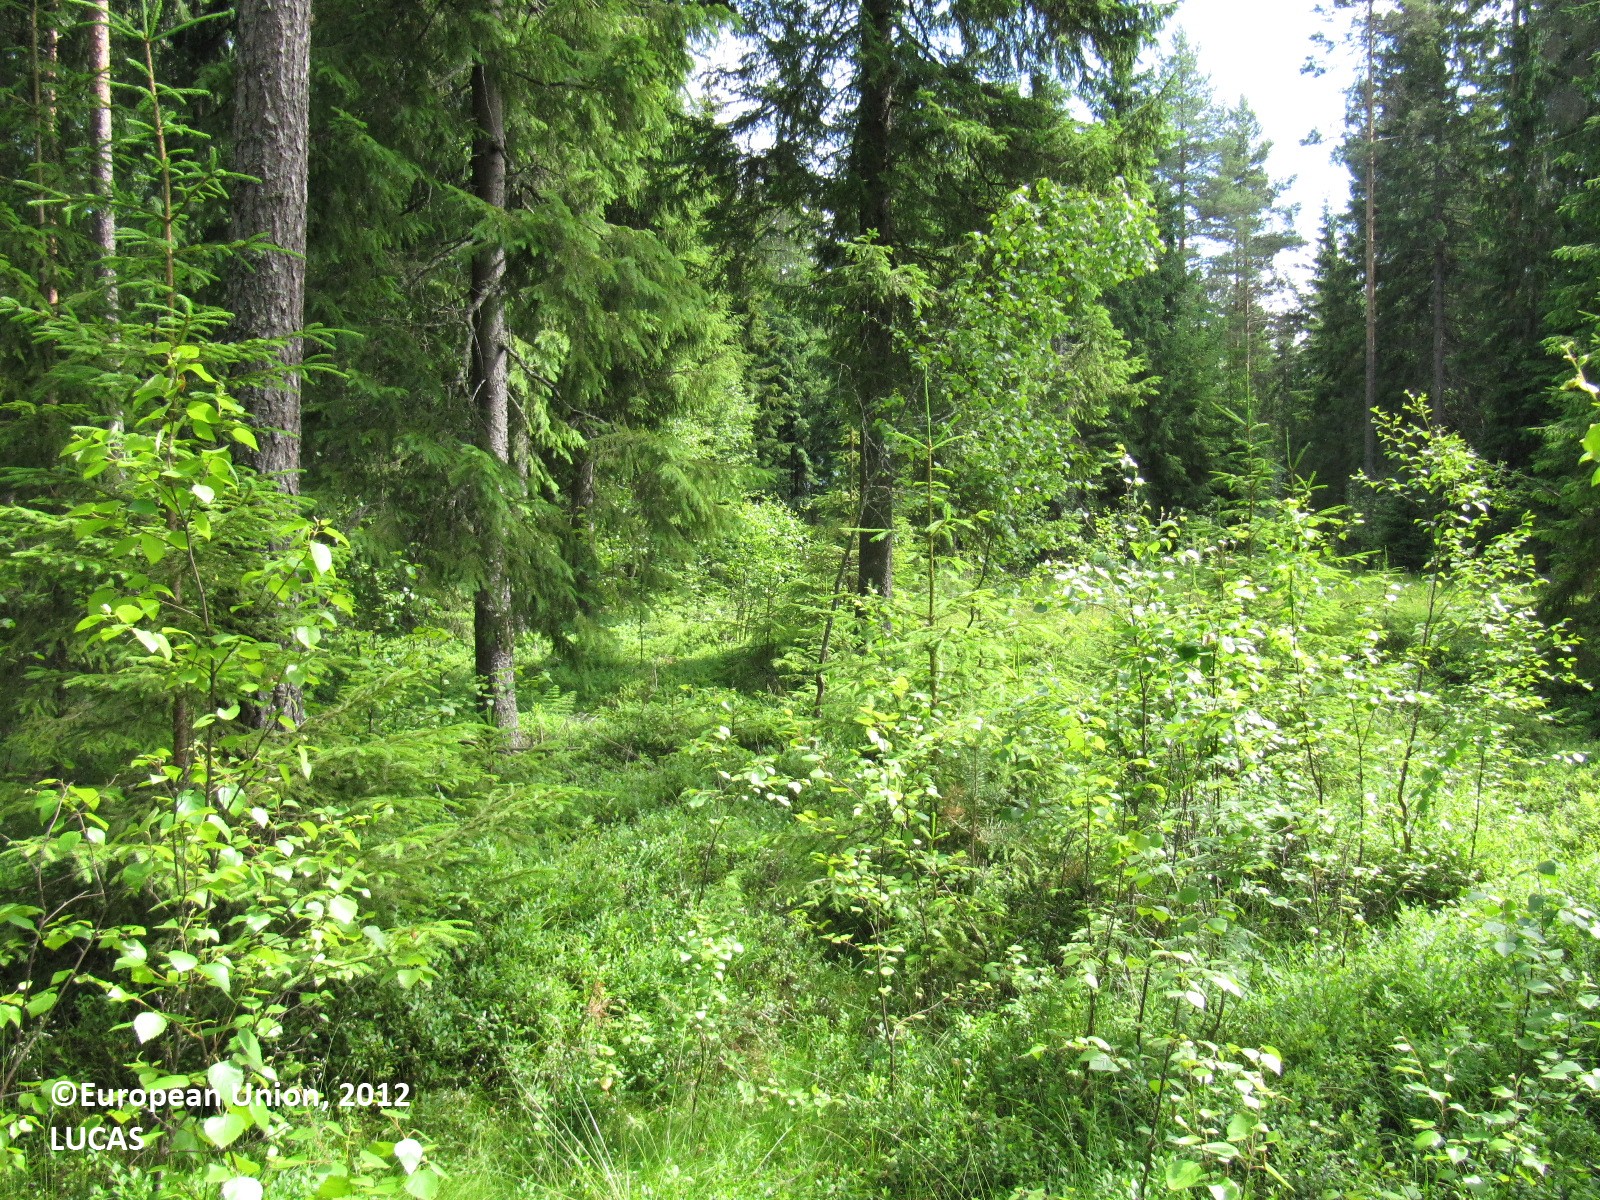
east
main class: Woodland
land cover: Other coniferous woodland
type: boreal forest
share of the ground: > 75 %
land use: Forestry
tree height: > 5 m
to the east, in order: Other coniferous woodland; Spruce dominated mixed woodland; Rivers and streams; Spruce dominated mixed woodland; Grassland with sparse tree/shrub cover; Other mixed woodland
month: July
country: FI
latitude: 60.9864
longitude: 23.3702
